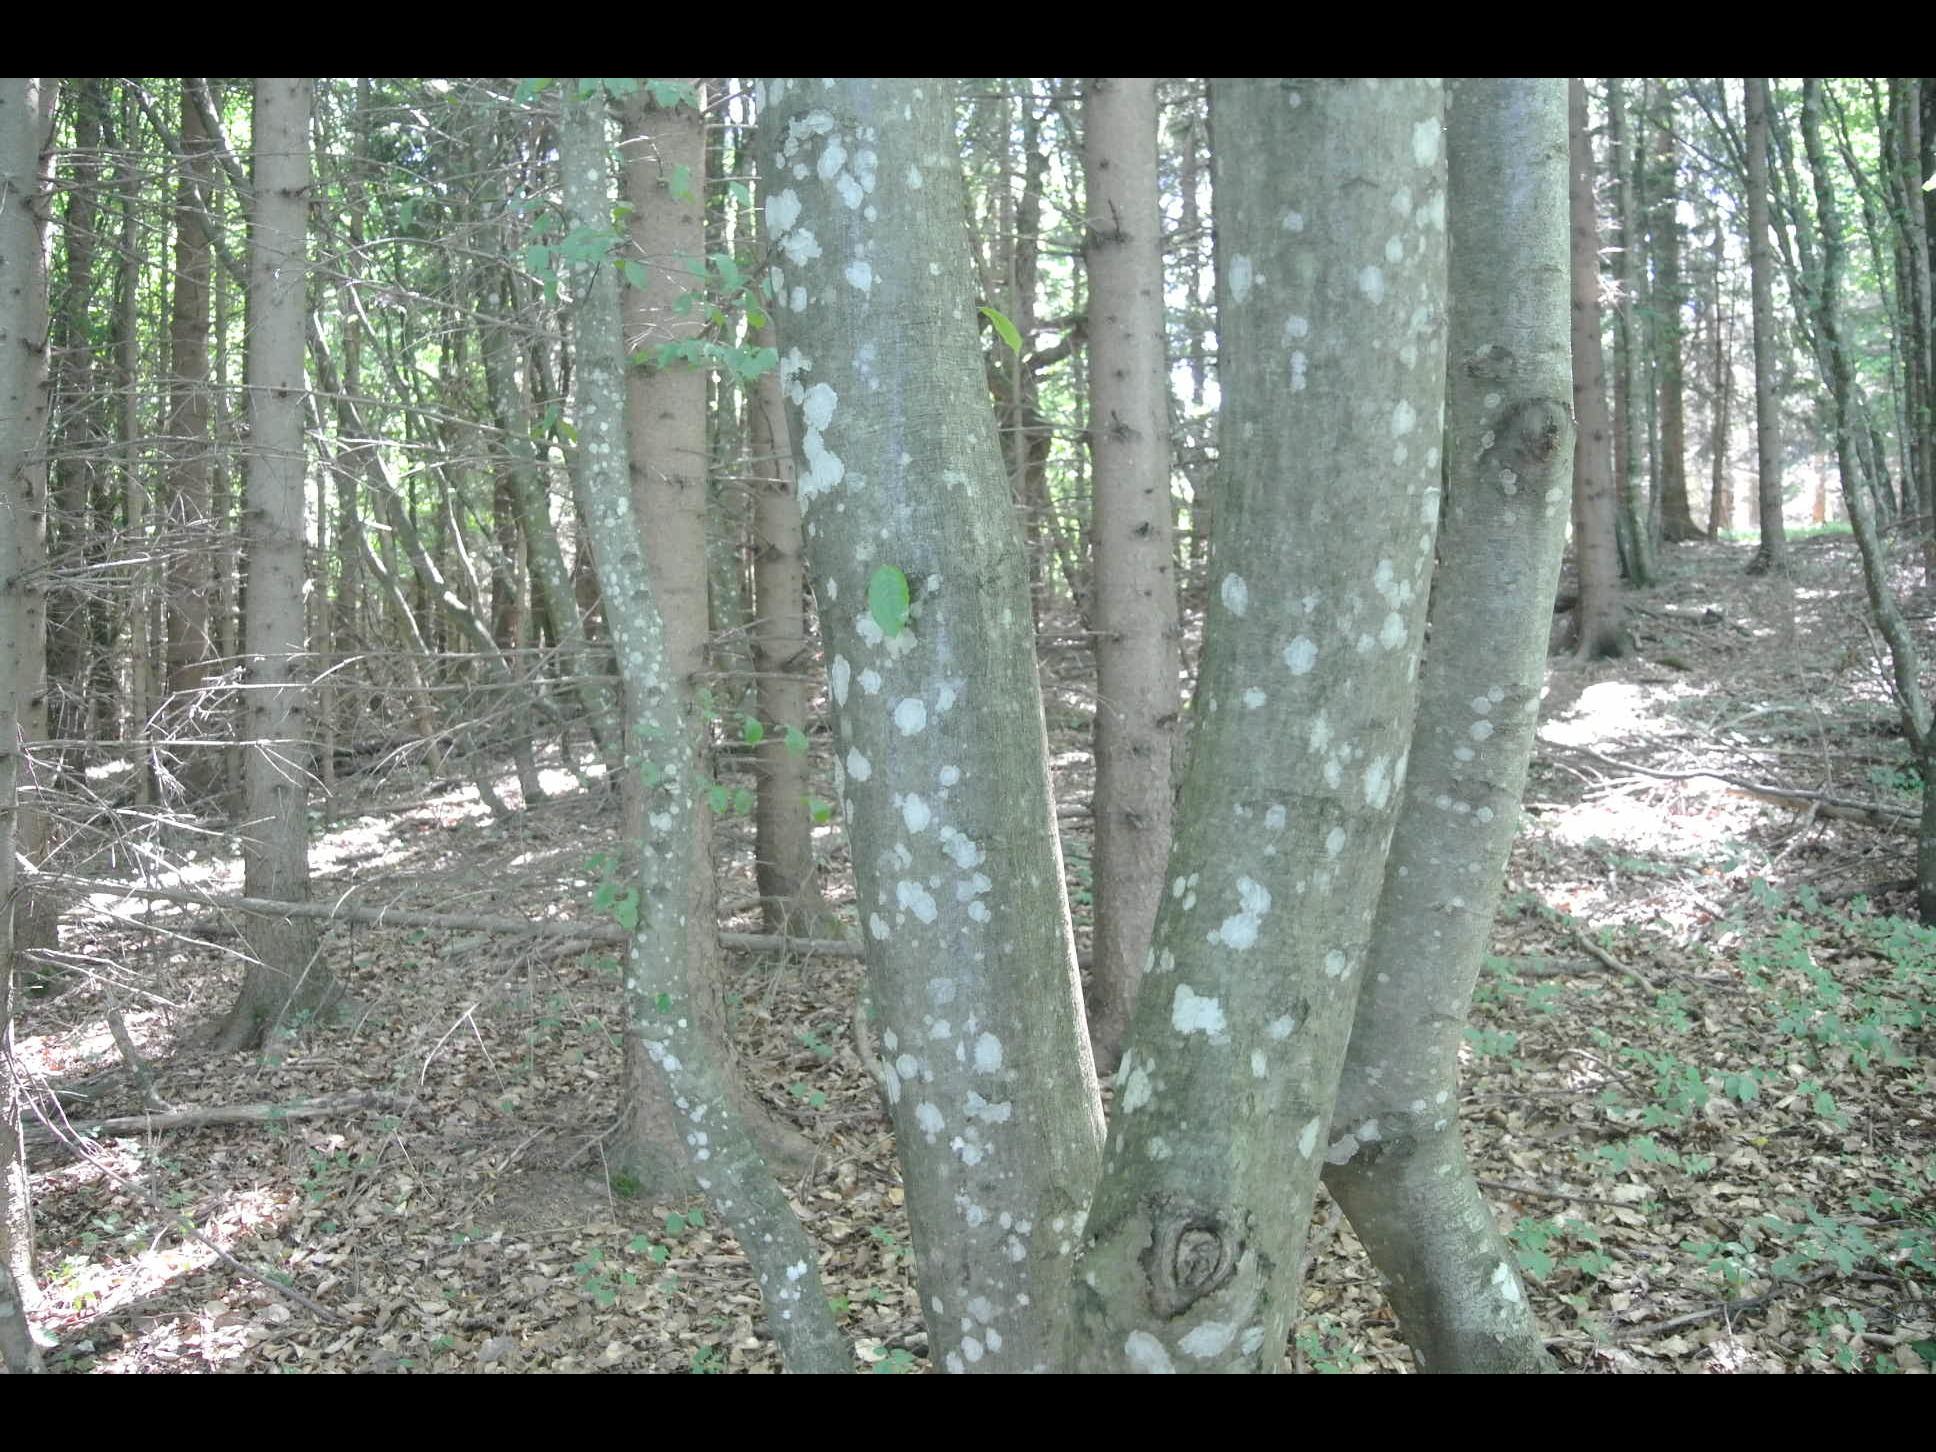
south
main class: Woodland
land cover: Spruce dominated mixed woodland
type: alpine coniferous forest
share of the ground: > 75 %
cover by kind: broadleaved forest trees 70 %, coniferous forest trees 30 %
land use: Forestry
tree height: > 5 m
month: July
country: AT
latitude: 48.0095
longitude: 15.5921
